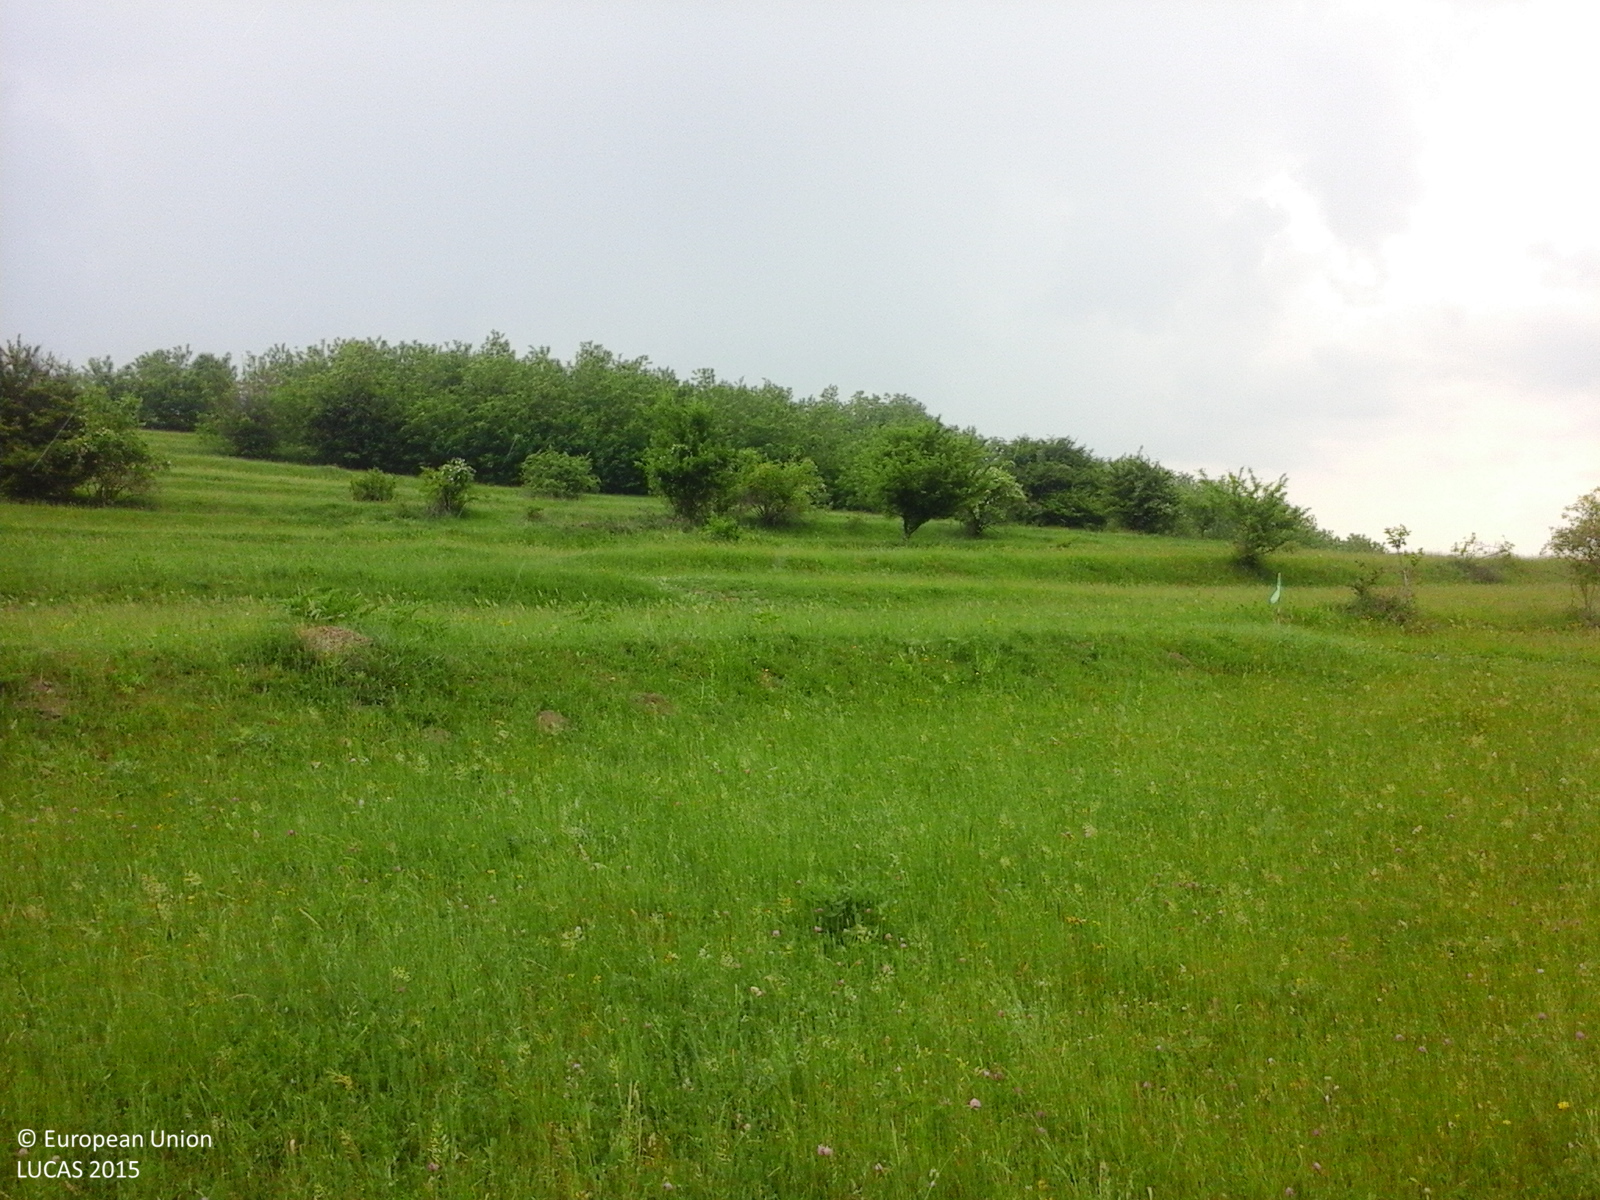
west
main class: Grassland
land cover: Grassland without tree/shrub cover
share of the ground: > 75 %
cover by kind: herbaceous plants 100 %
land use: Agriculture (excluding fallow land and kitchen gardens)
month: June
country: RO
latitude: 46.3846
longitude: 26.4771
